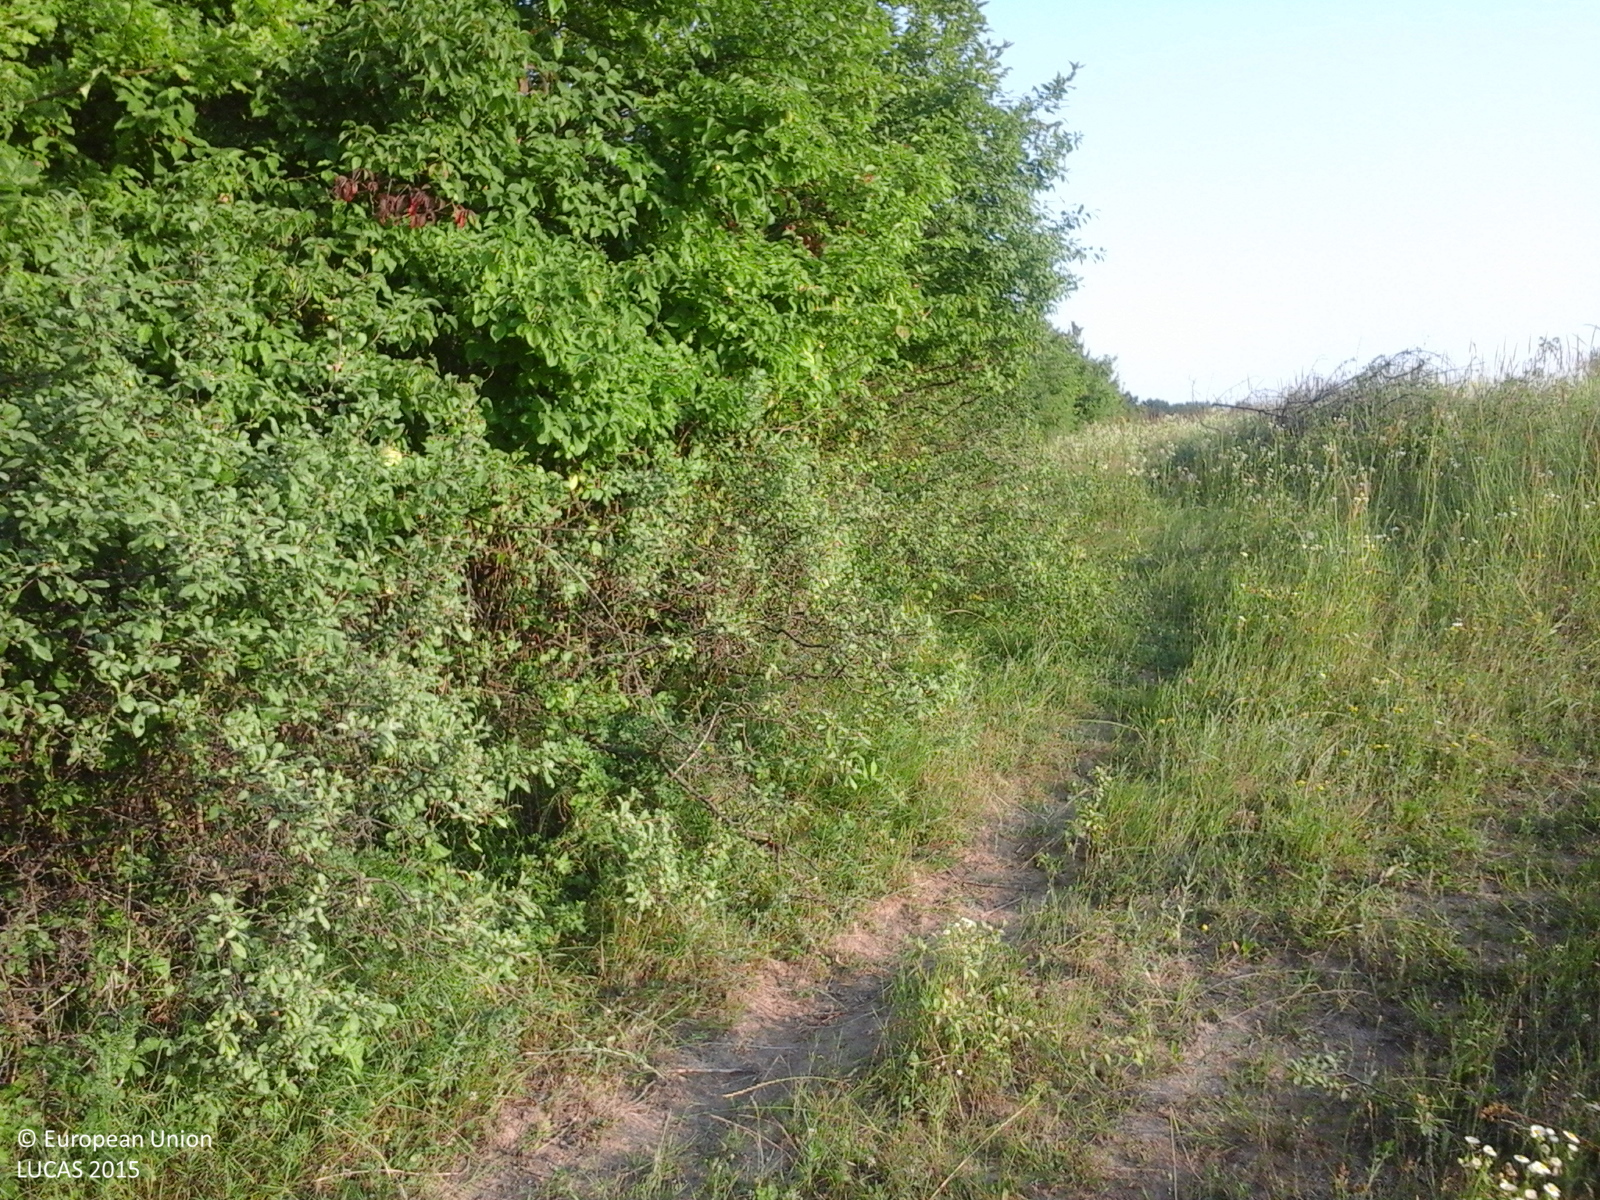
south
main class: Shrubland
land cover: Shrubland with sparse tree cover
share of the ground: > 75 %
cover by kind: herbaceous plants 60 %, shrubs 35 %, broadleaved forest trees 5 %
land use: Agriculture (excluding fallow land and kitchen gardens)
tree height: > 5 m
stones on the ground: < 10 %
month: July
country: RO
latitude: 44.7564
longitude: 25.3639
